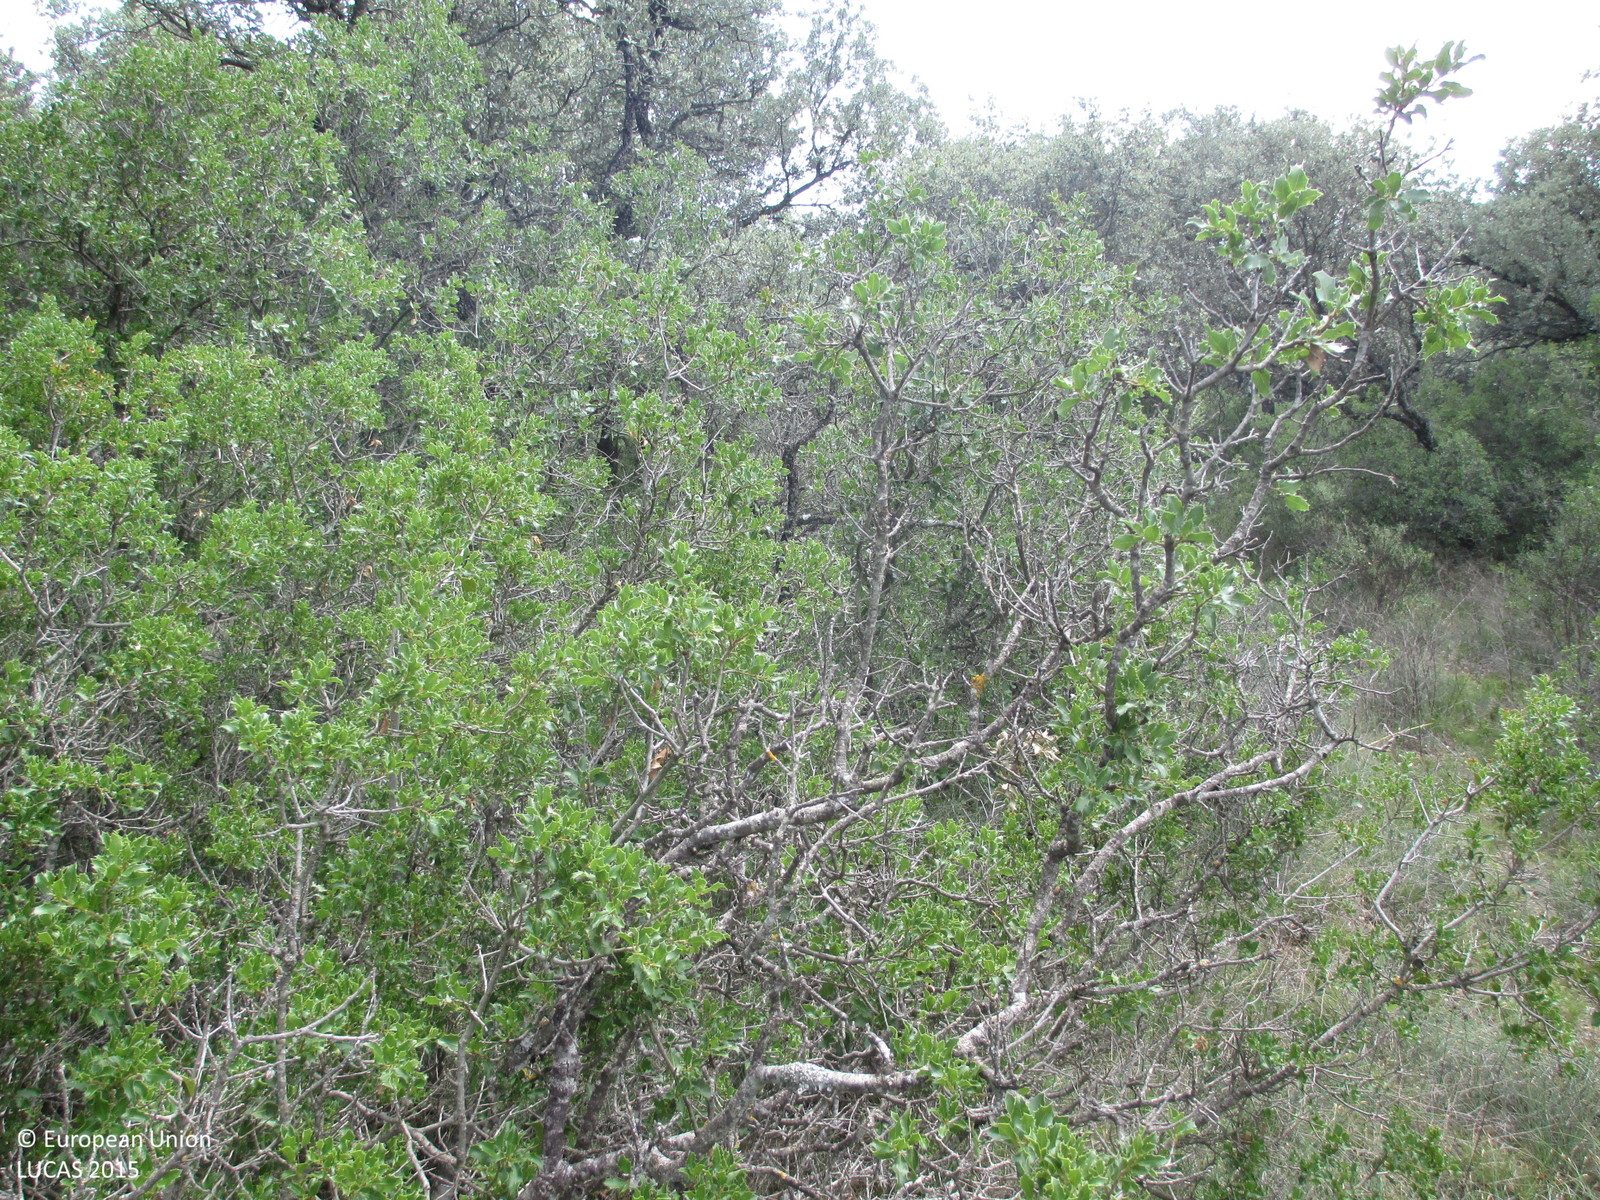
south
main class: Woodland
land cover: Broadleaved woodland
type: broadleaved evergreen forest
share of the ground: > 75 %
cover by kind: broadleaved forest trees 100 %
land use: Semi-natural and natural areas not in use
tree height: > 5 m
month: June
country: ES
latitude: 42.2004
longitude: -0.4752
